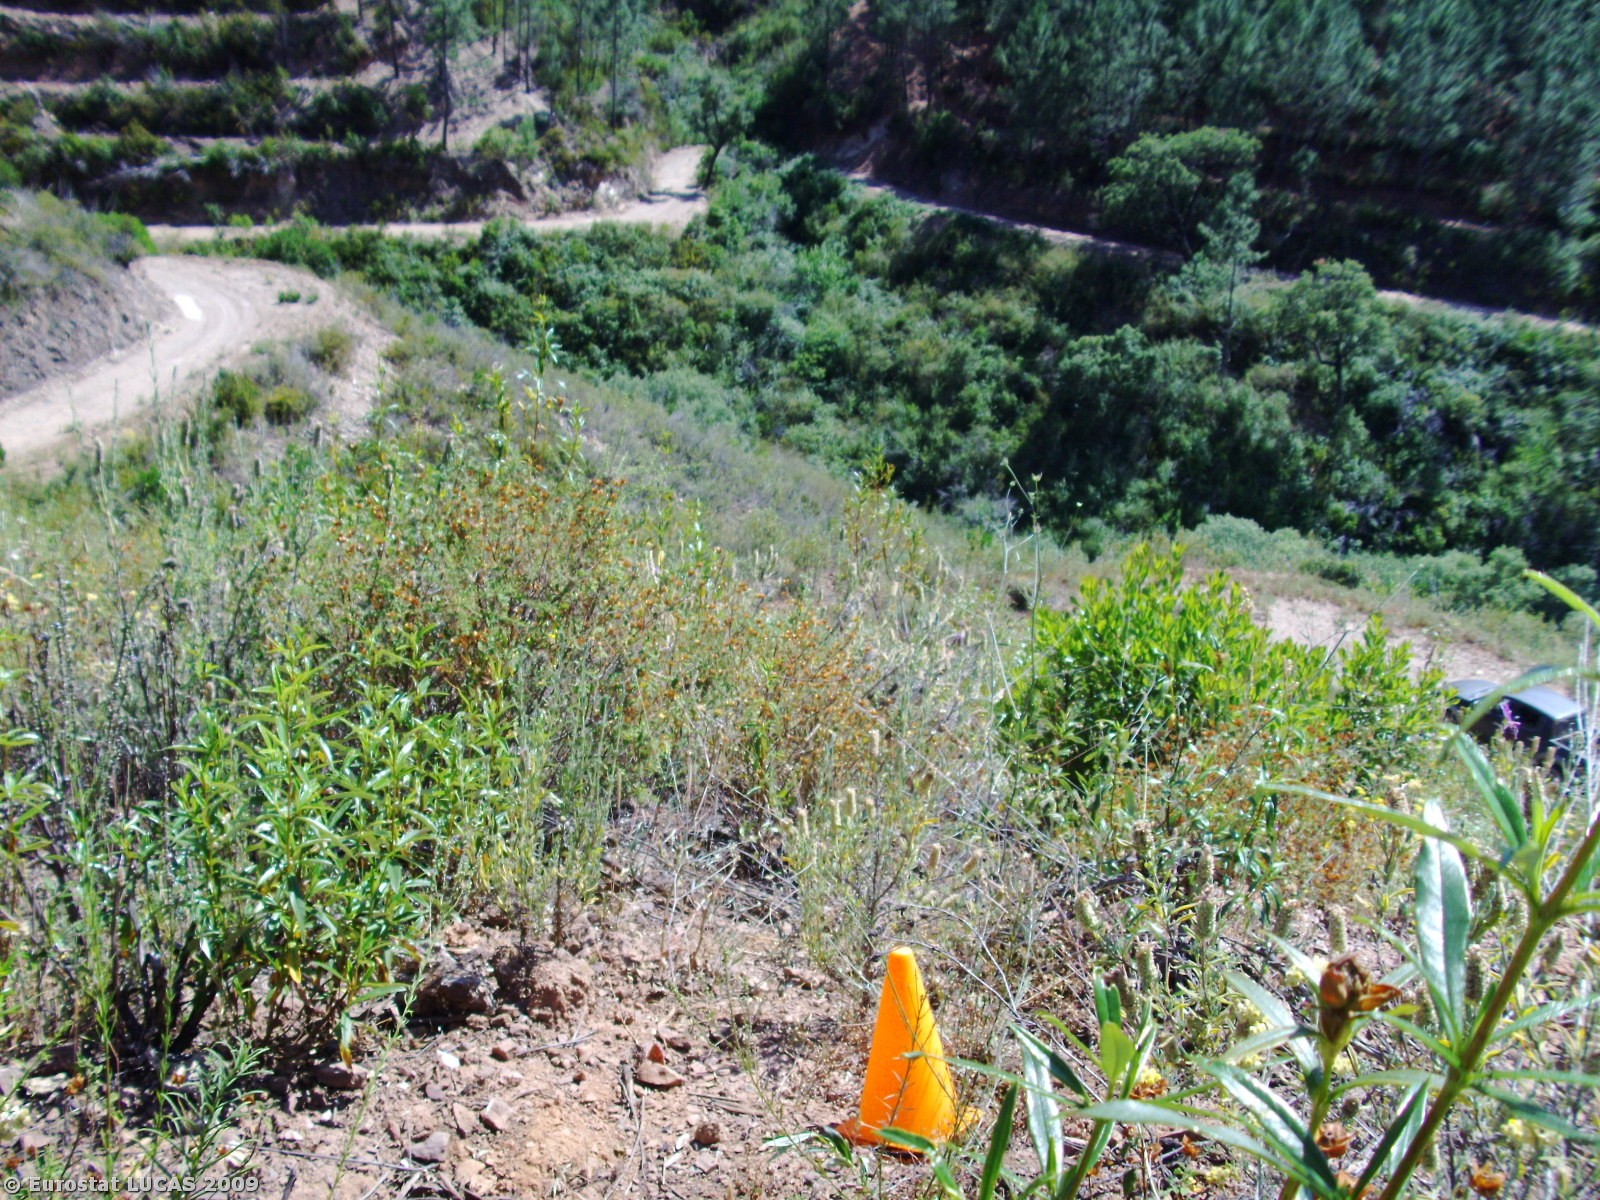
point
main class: Woodland
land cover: Coniferous woodland
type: coniferous forest of the mediterranean region
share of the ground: 25 - 50 %
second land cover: Shrubland with sparse tree cover
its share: 25 - 50 %
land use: Nature reserves
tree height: > 5 m
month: June
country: PT
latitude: 37.3014
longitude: -8.4268
